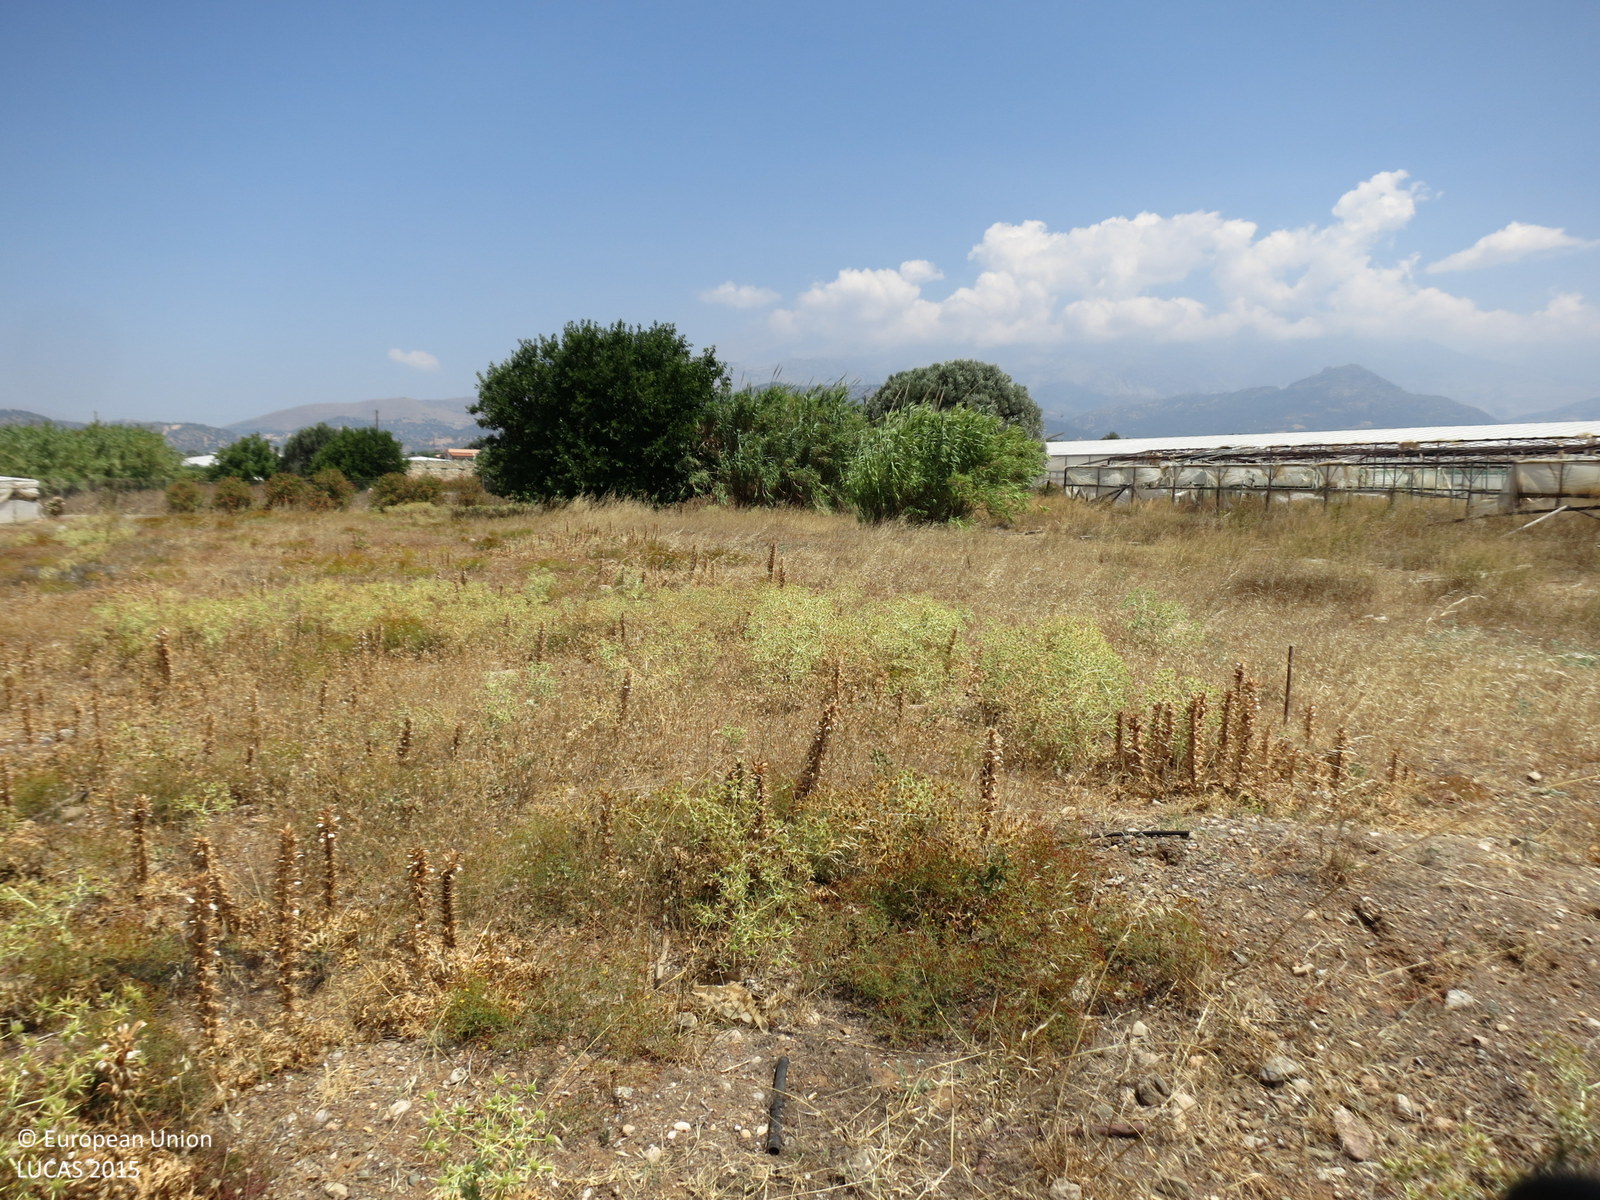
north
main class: Grassland
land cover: Spontaneously vegetated surfaces
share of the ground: > 75 %
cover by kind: herbaceous plants 95 %, shrubs 5 %
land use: Fallow land
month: July
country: GR
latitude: 35.0790
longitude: 24.7571
